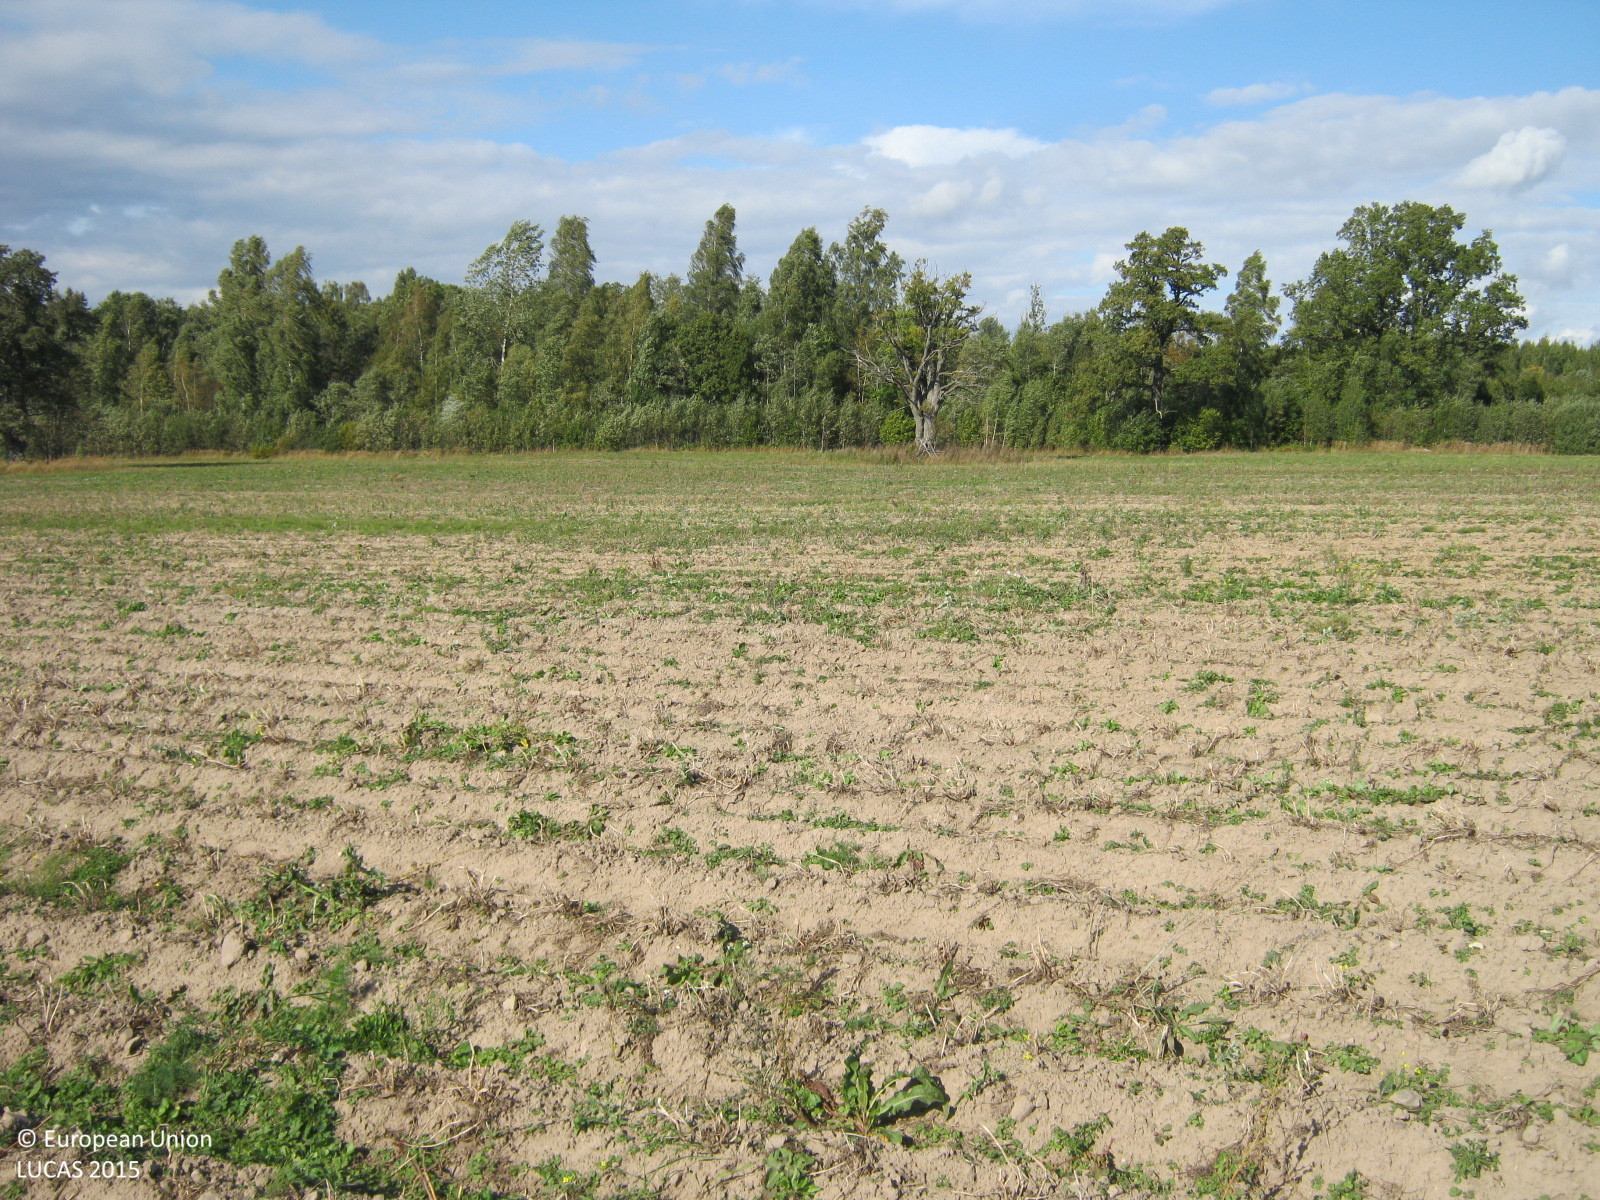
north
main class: Cropland
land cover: Potatoes
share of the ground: < 10 %
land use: Agriculture (excluding fallow land and kitchen gardens)
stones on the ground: < 10 %
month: September
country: LV
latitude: 57.3390
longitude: 24.6322
